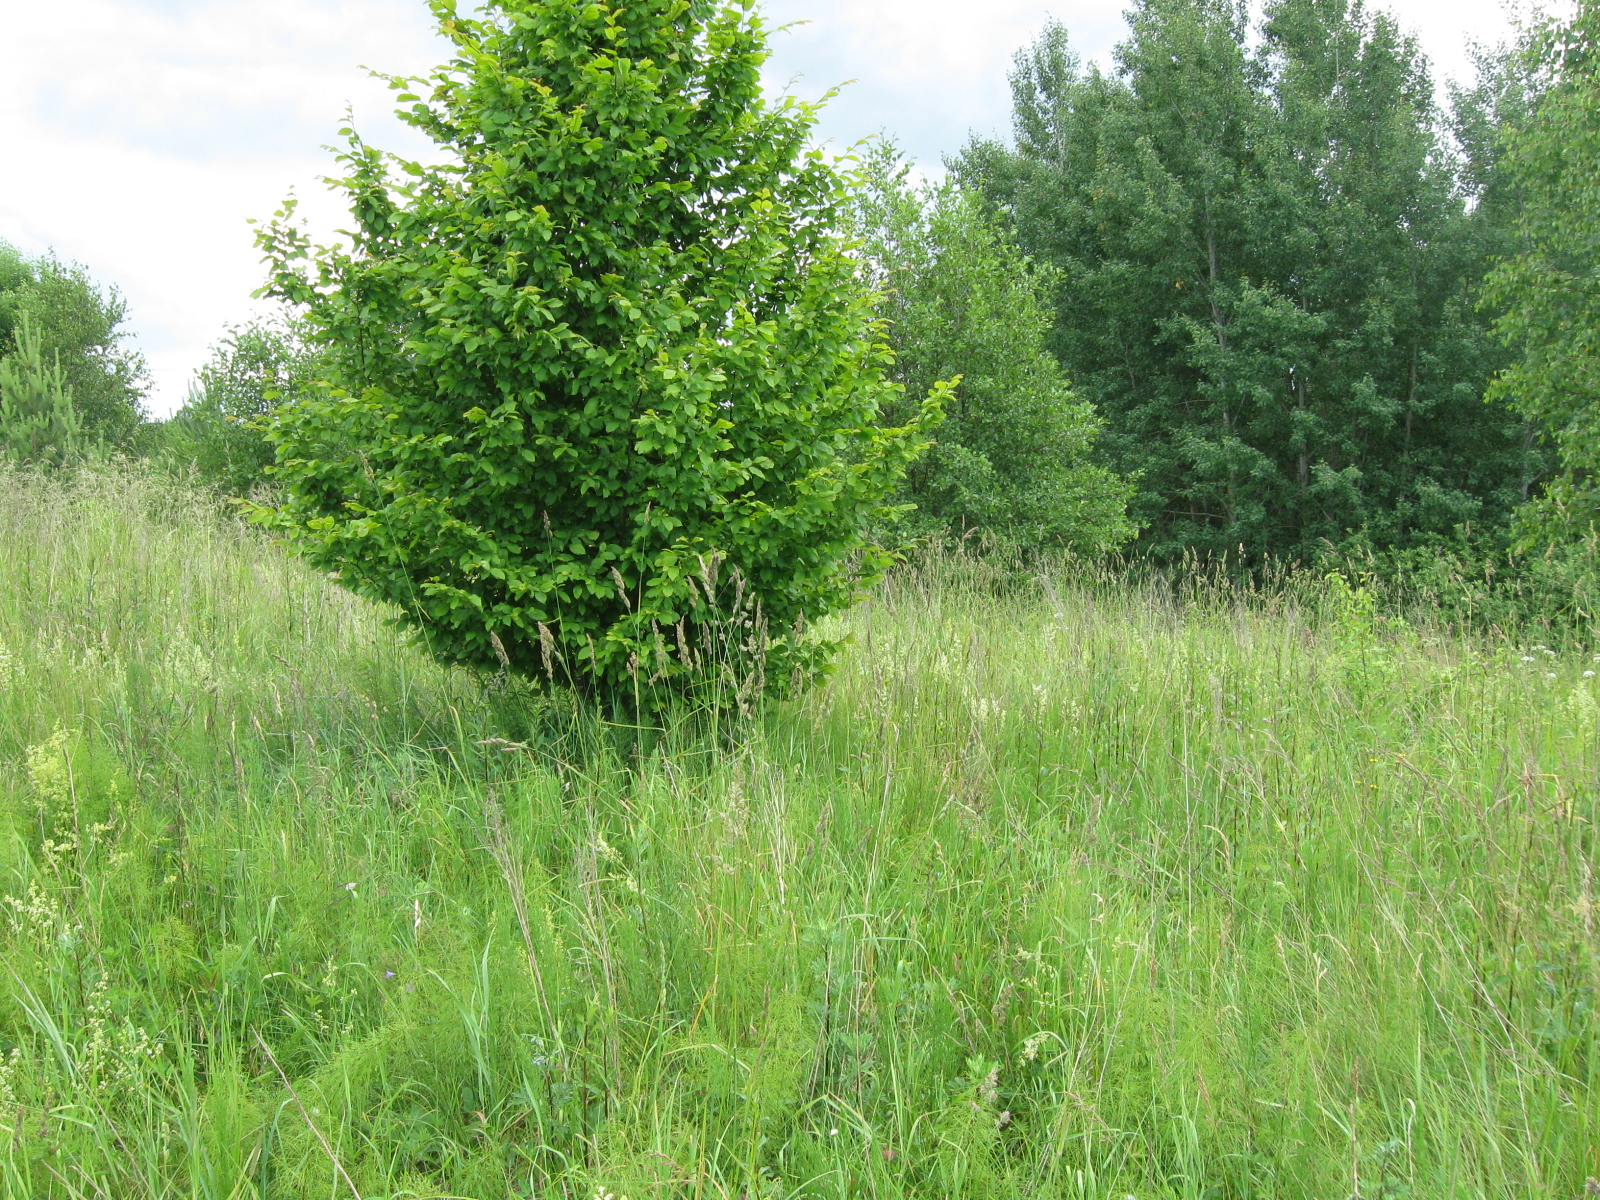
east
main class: Grassland
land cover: Grassland with sparse tree/shrub cover
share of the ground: > 75 %
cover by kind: herbaceous plants 90 %, broadleaved forest trees 5 %, shrubs 5 %
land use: Agriculture (excluding fallow land and kitchen gardens)
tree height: < 5 m
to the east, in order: Grassland with sparse tree/shrub cover; Broadleaved woodland; Ditches and canals; Broadleaved woodland; Grassland with sparse tree/shrub cover; Tracks; Grass margins; Electric lines; Triticale
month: June
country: LT
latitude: 54.5076
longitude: 24.4180
